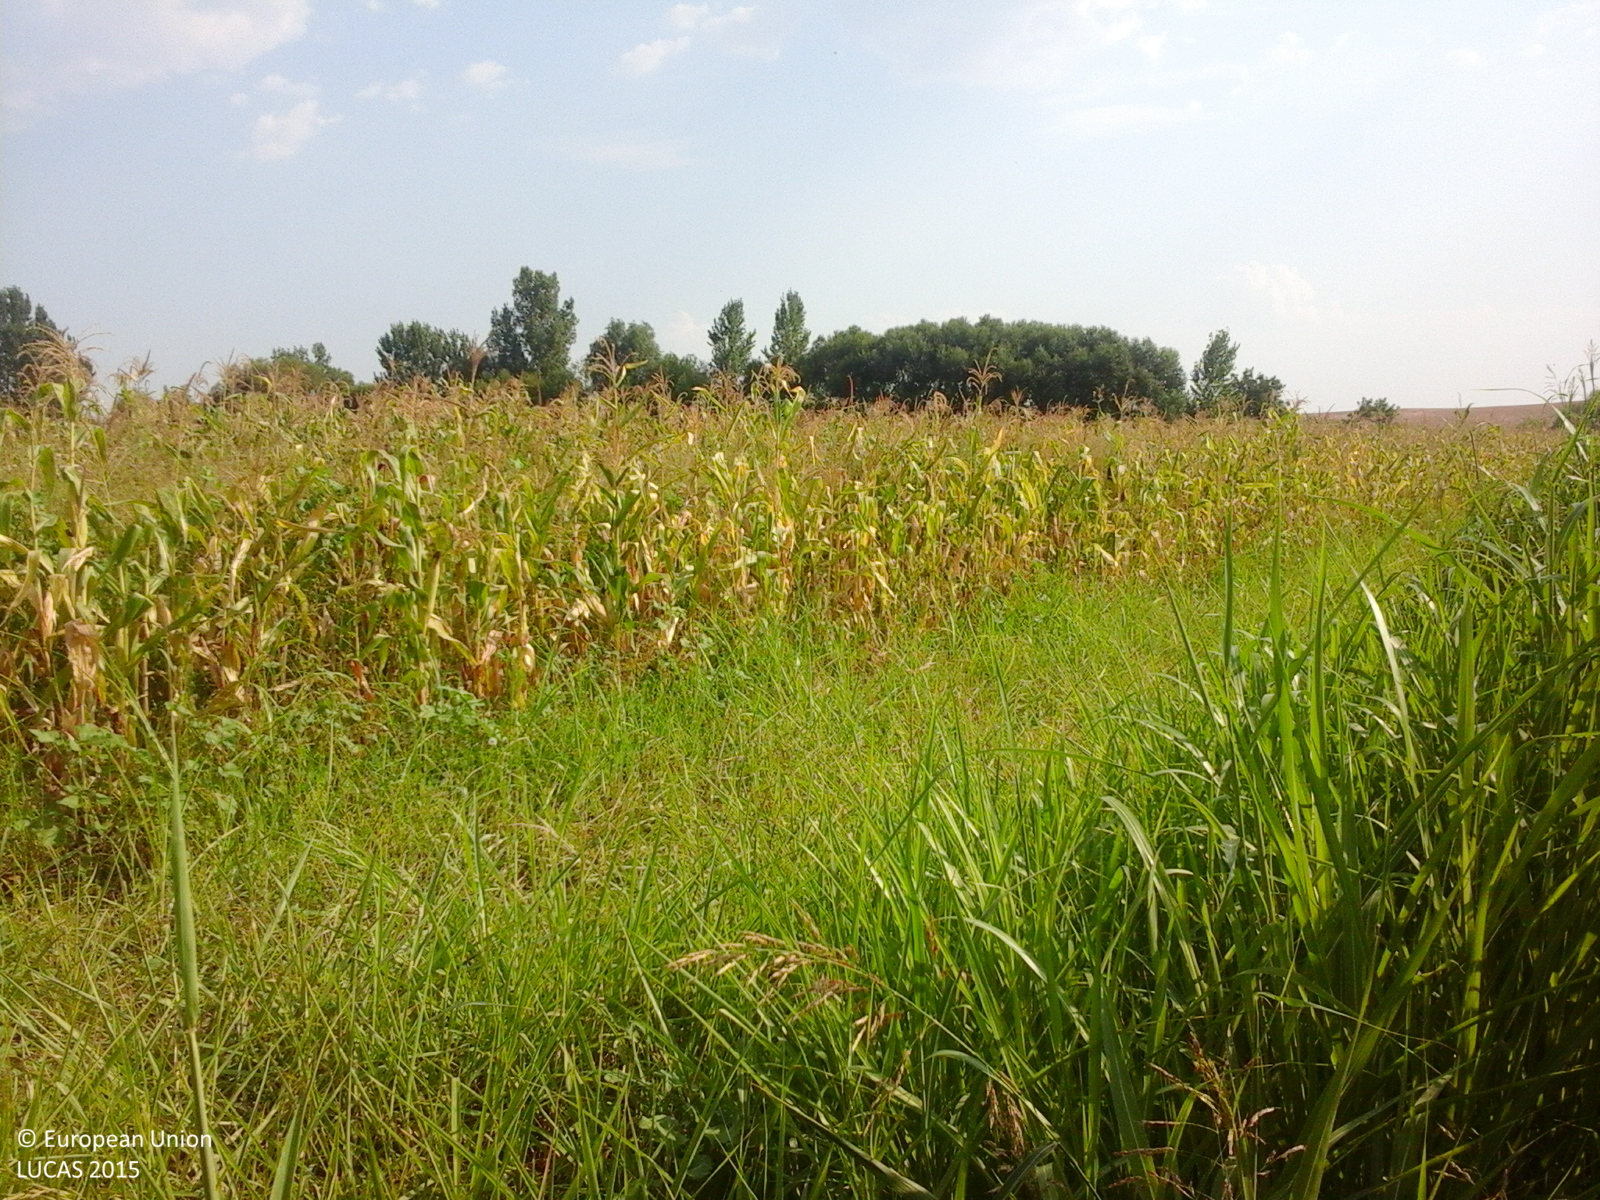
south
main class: Cropland
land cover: Maize
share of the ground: > 75 %
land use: Agriculture (excluding fallow land and kitchen gardens)
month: August
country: RO
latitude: 44.0858
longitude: 23.0691
